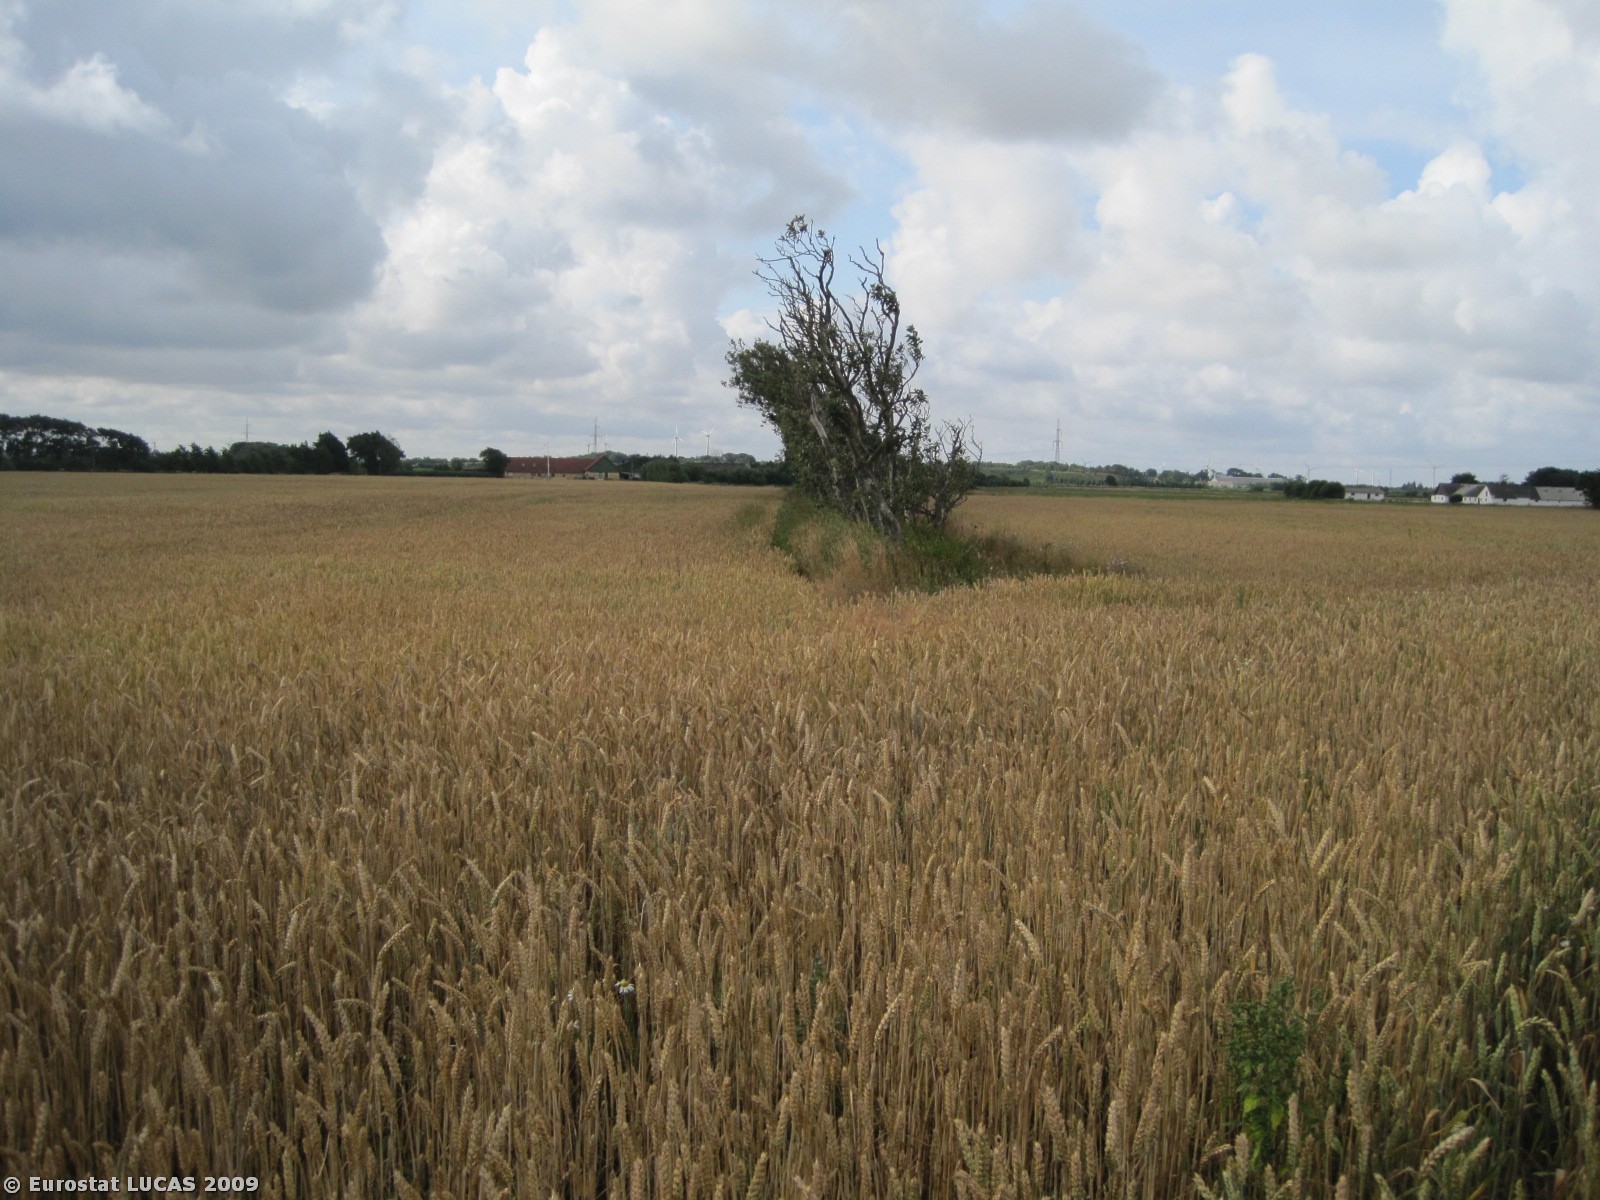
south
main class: Cropland
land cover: Common wheat
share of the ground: > 75 %
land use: Agriculture (excluding fallow land and kitchen gardens)
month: July
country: DK
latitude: 57.0483
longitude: 9.2264
